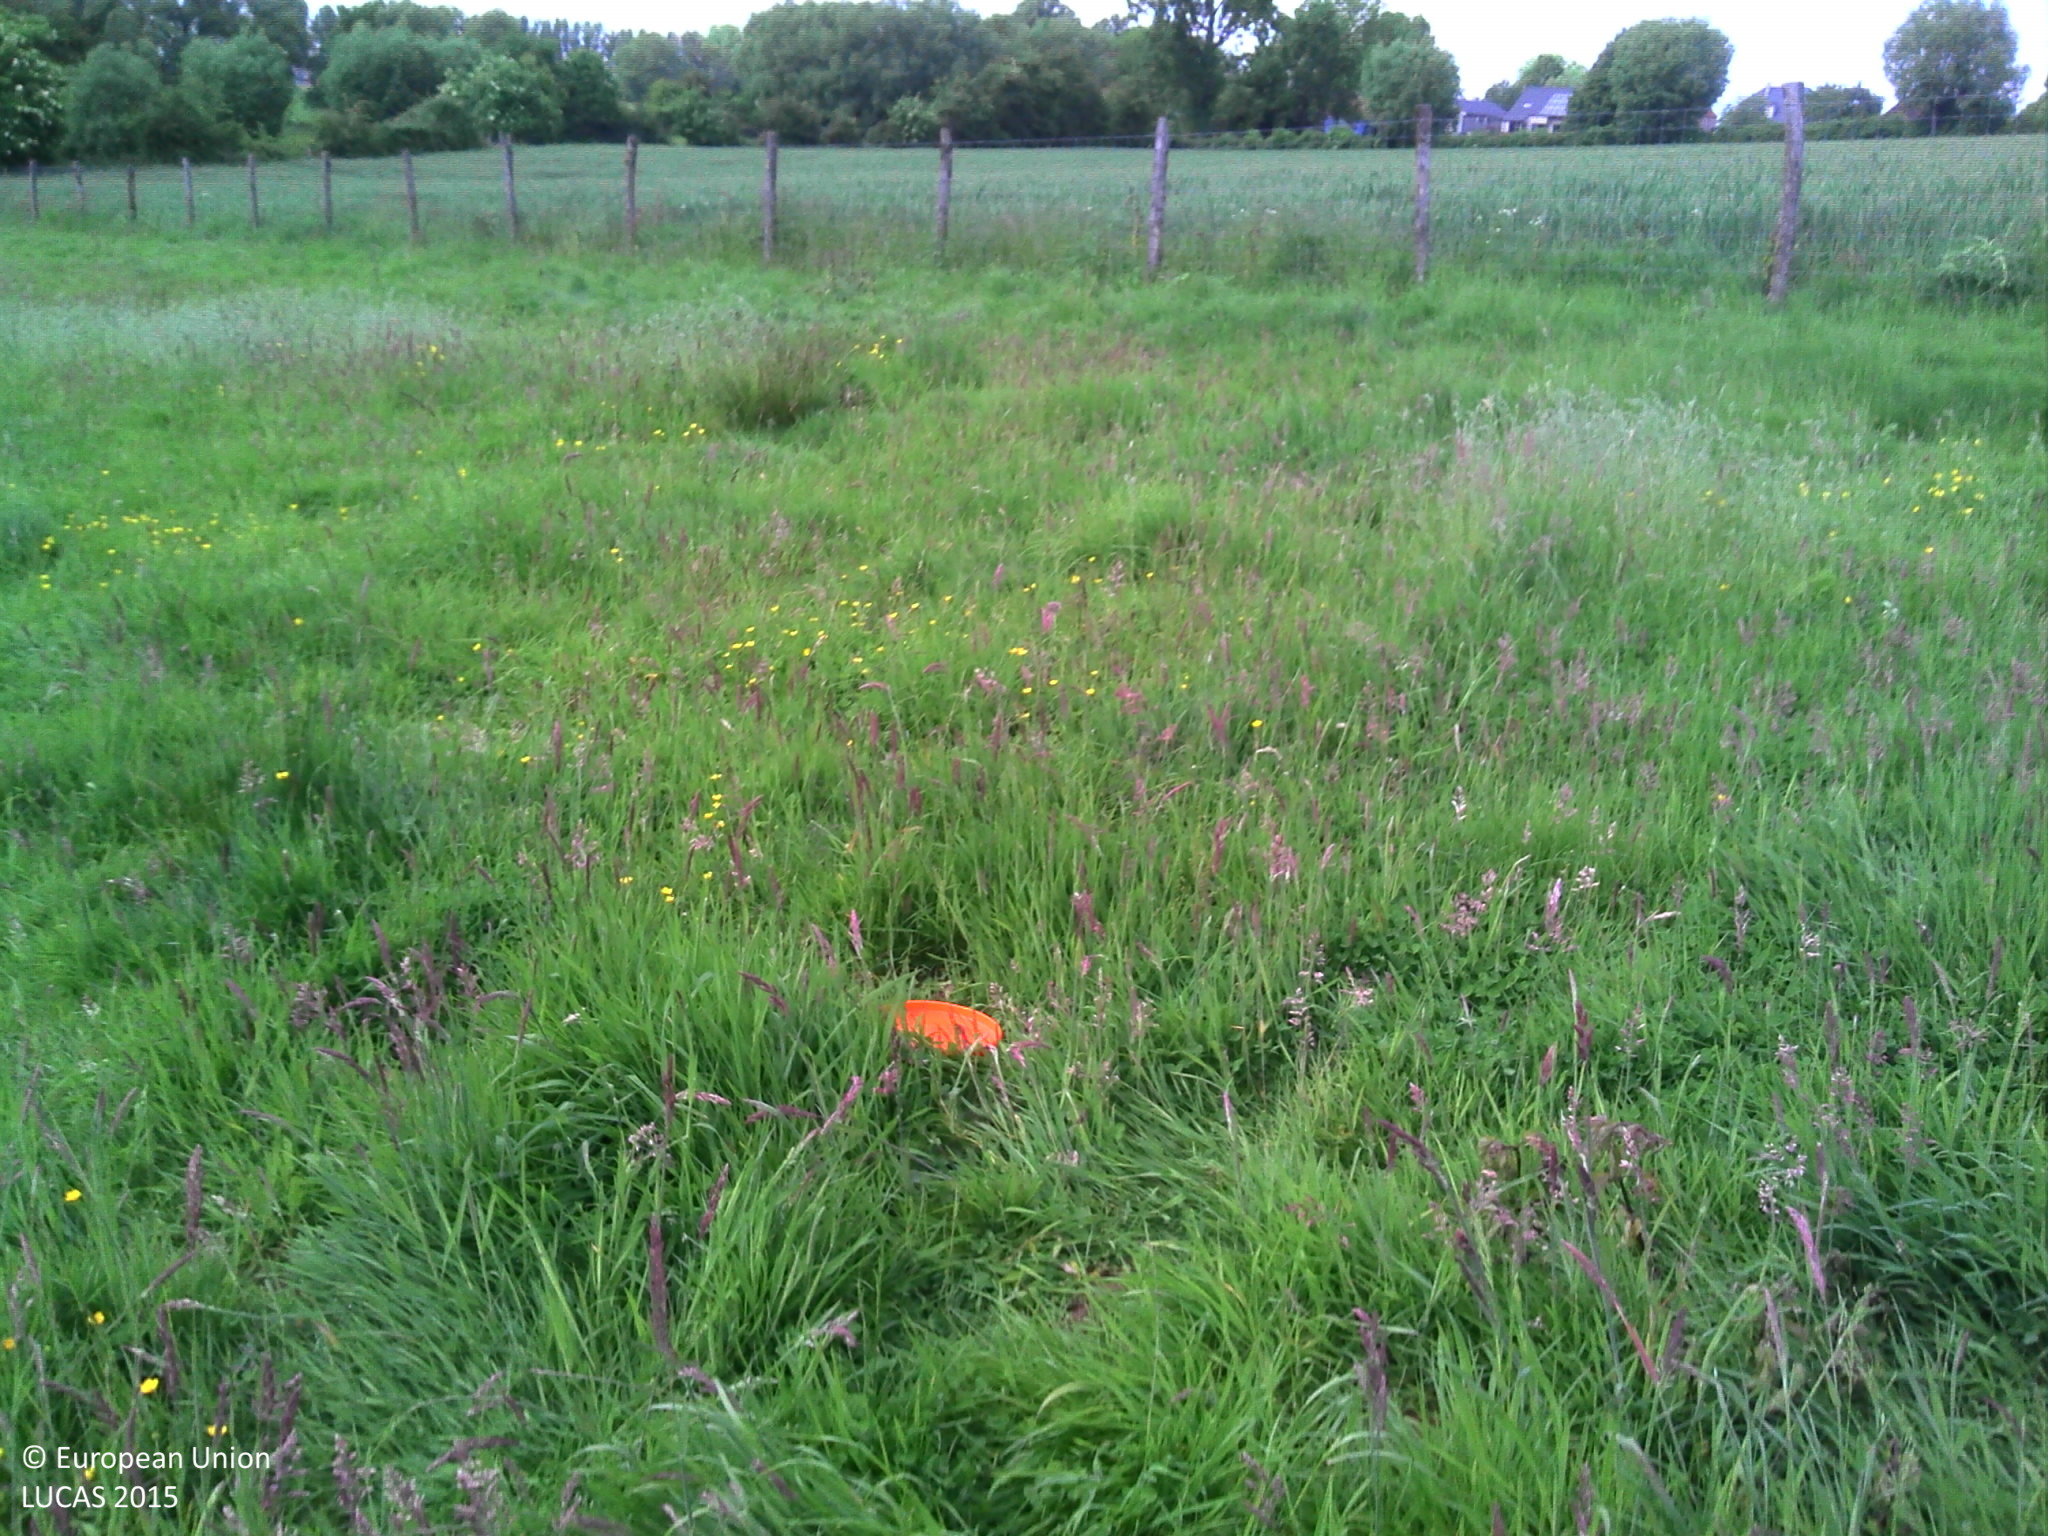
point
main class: Grassland
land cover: Grassland without tree/shrub cover
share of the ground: > 75 %
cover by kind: herbaceous plants 100 %
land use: Agriculture (excluding fallow land and kitchen gardens)
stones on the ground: < 10 %
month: June
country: BE
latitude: 50.7833
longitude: 3.9945
